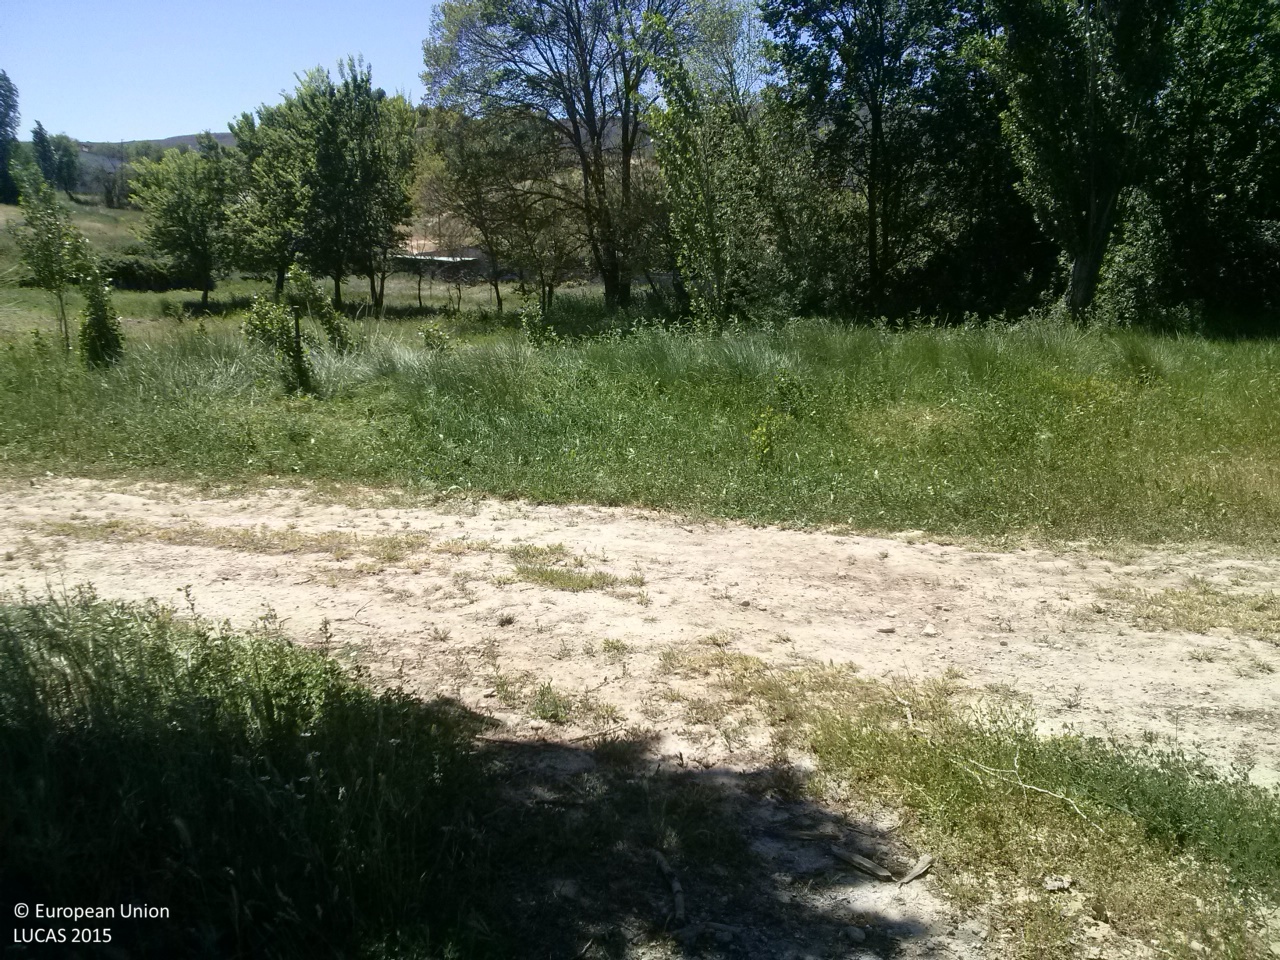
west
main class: Grassland
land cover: Grassland with sparse tree/shrub cover
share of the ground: 50 - 75 %
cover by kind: herbaceous plants 60 %, unconsolidated bare surface 35 %, broadleaved forest trees 5 %
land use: Abandoned areas
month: May
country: ES
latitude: 40.3639
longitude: -2.7553
